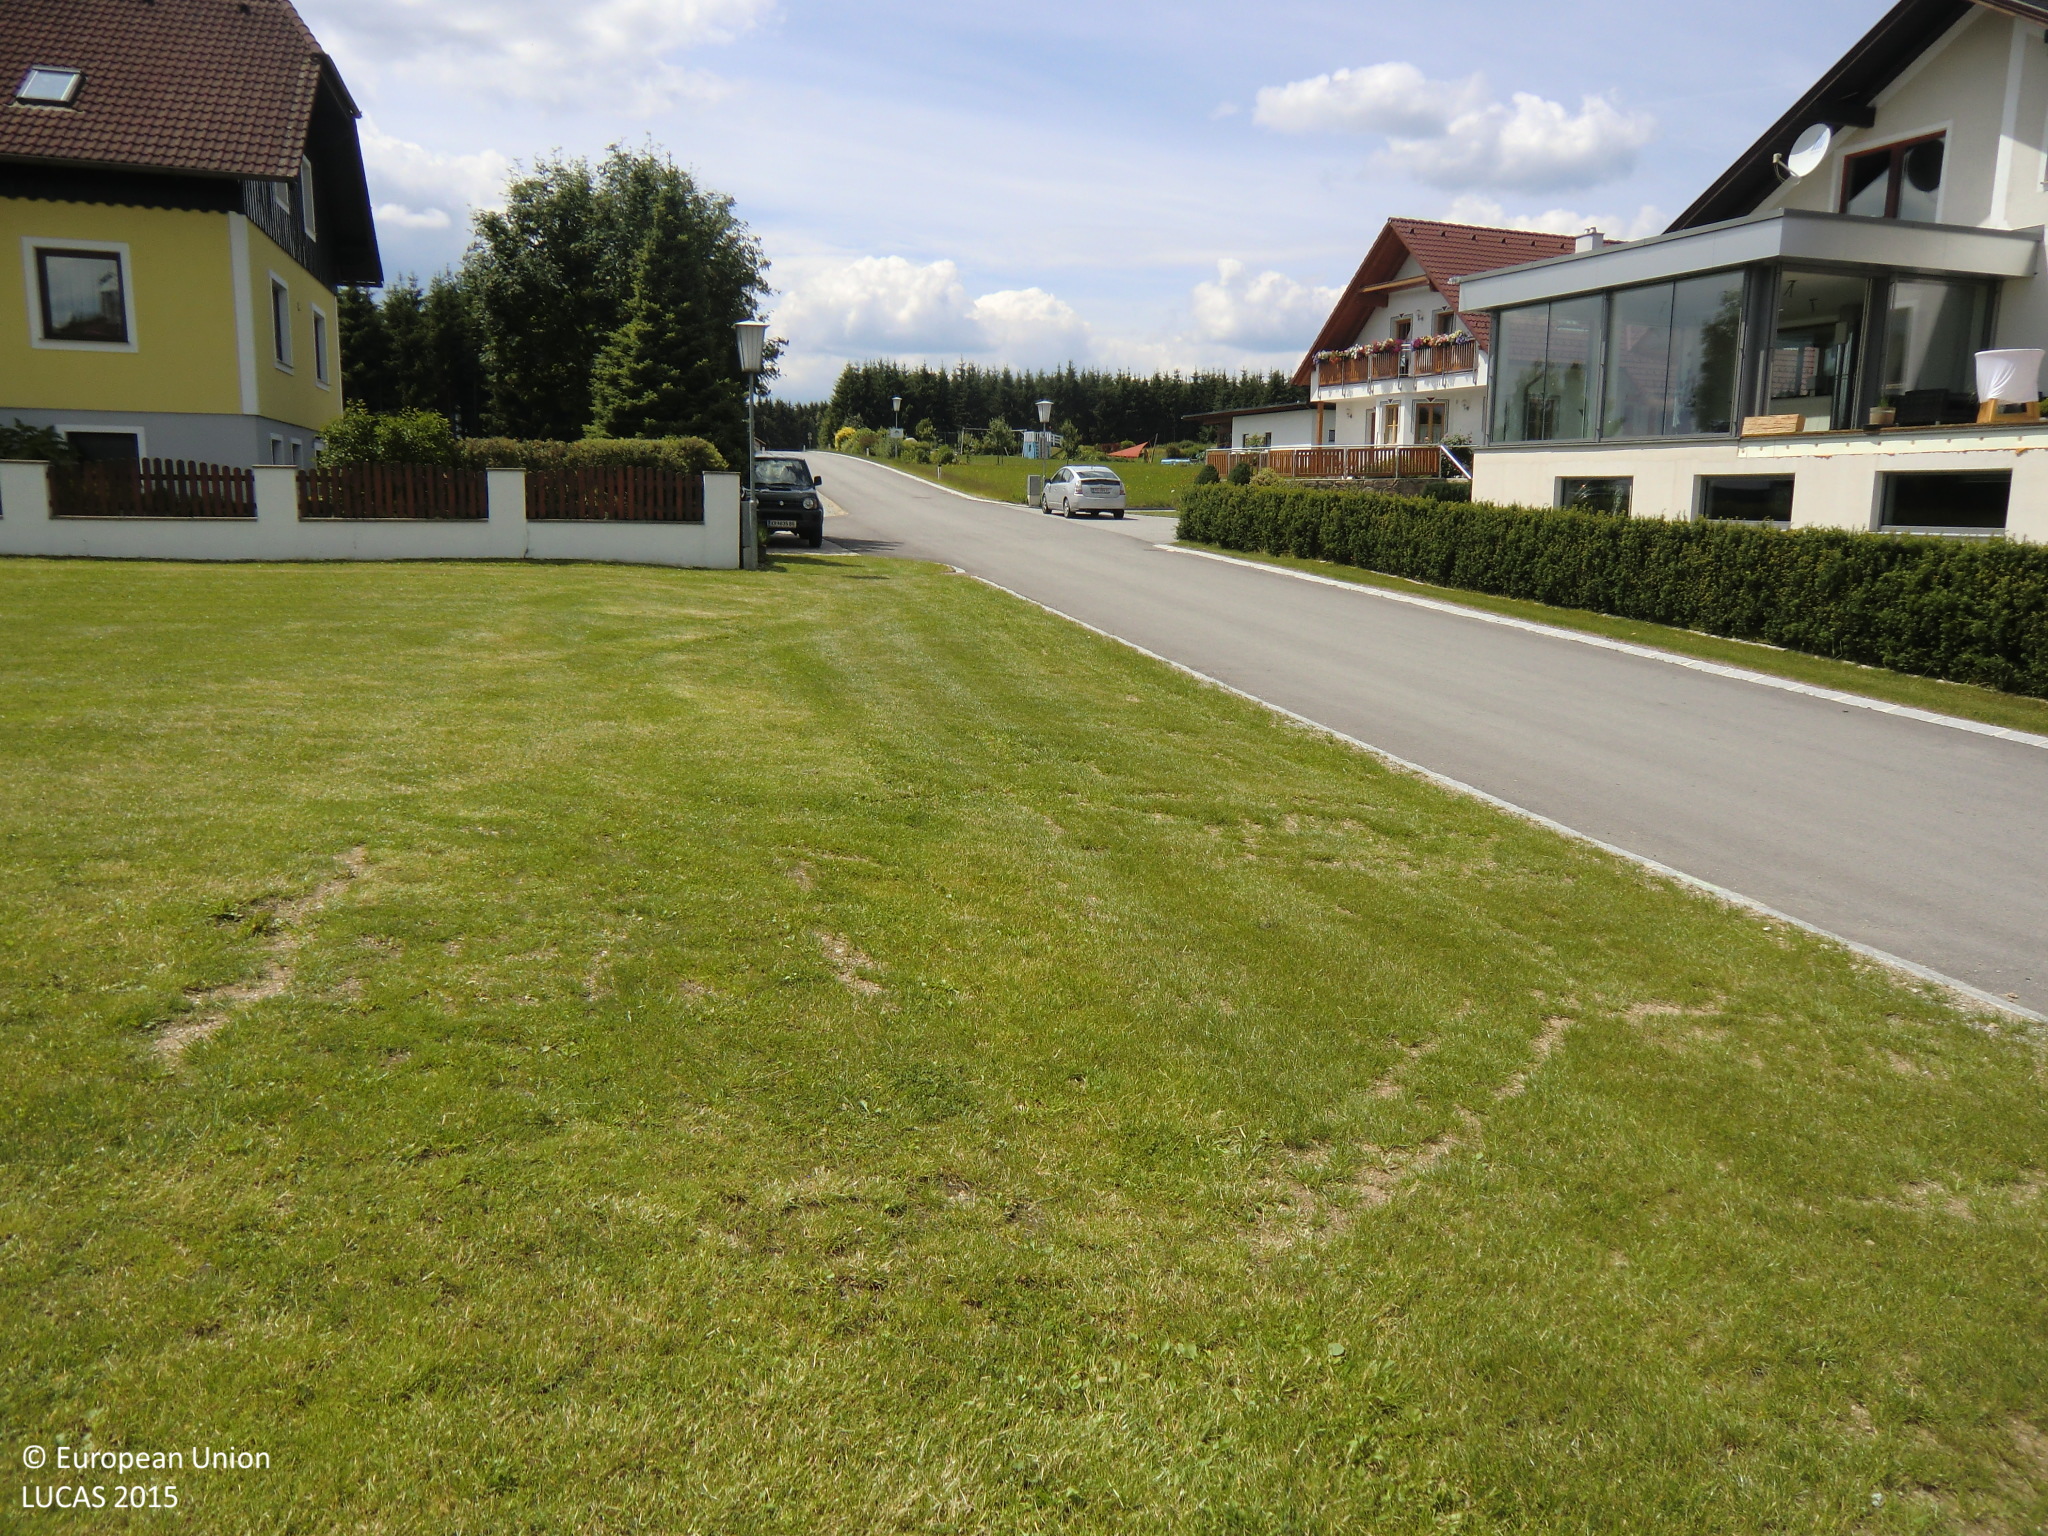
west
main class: Grassland
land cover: Grassland without tree/shrub cover
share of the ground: > 75 %
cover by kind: herbaceous plants 100 %
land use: Residential
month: June
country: AT
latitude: 48.5391
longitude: 15.0809
